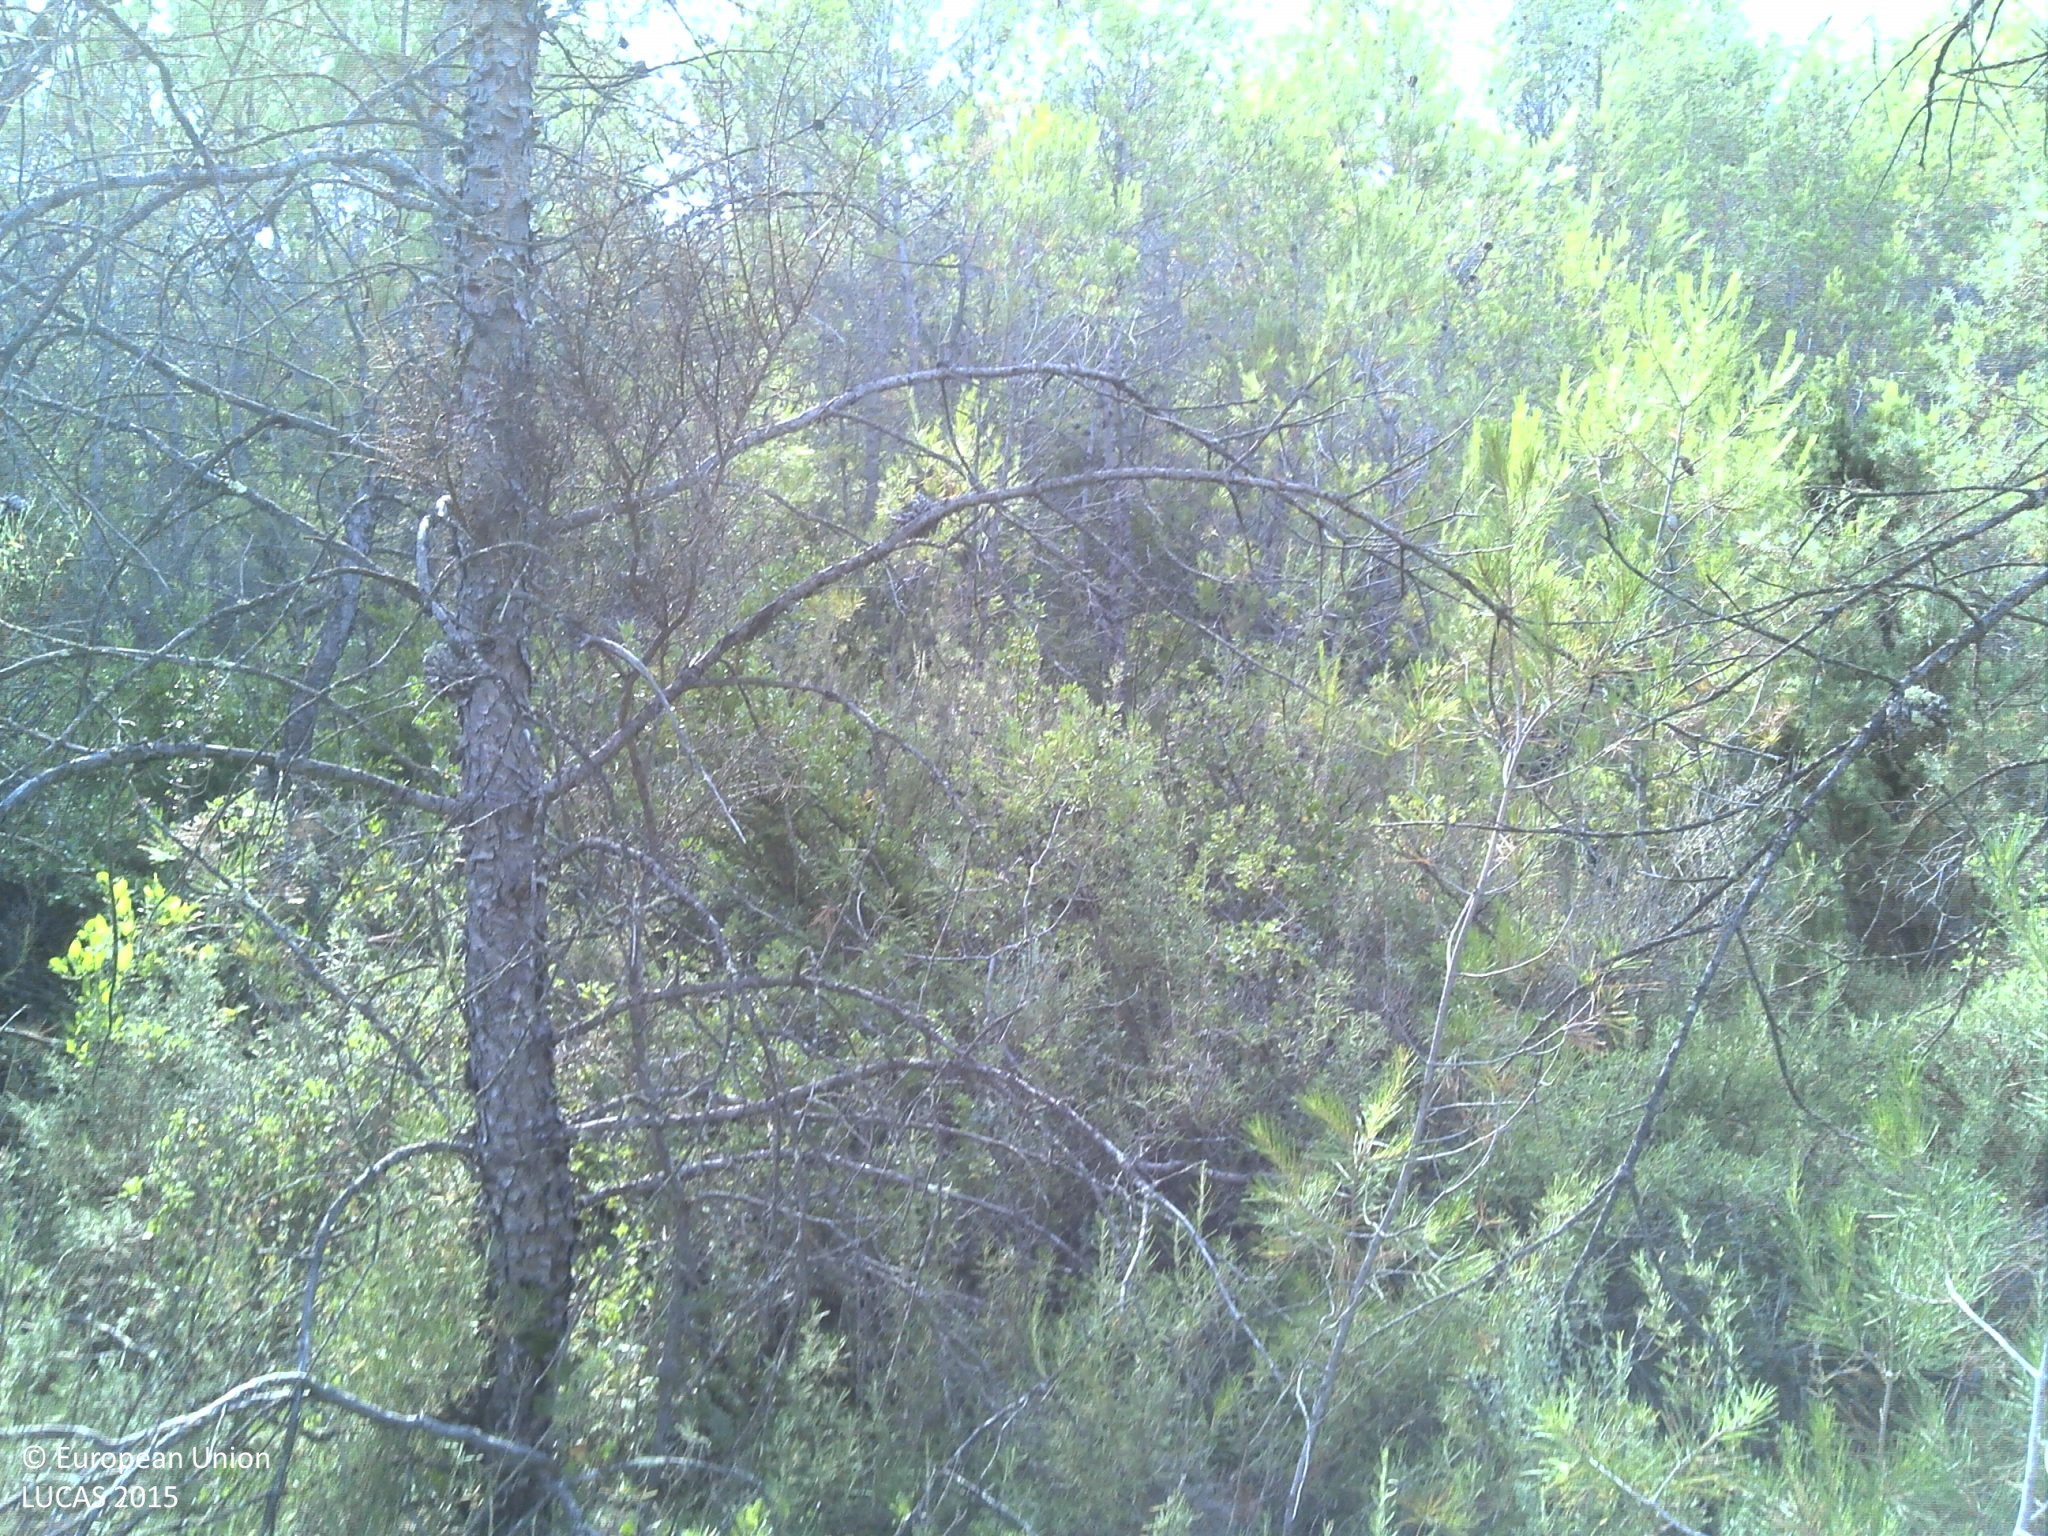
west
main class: Woodland
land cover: Pine dominated mixed woodland
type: coniferous forest of the mediterranean region
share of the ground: > 75 %
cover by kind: coniferous forest trees 50 %, broadleaved forest trees 25 %, herbaceous plants 15 %, unconsolidated bare surface 10 %
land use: Semi-natural and natural areas not in use
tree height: > 5 m
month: July
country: FR
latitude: 43.7780
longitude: 3.9827
